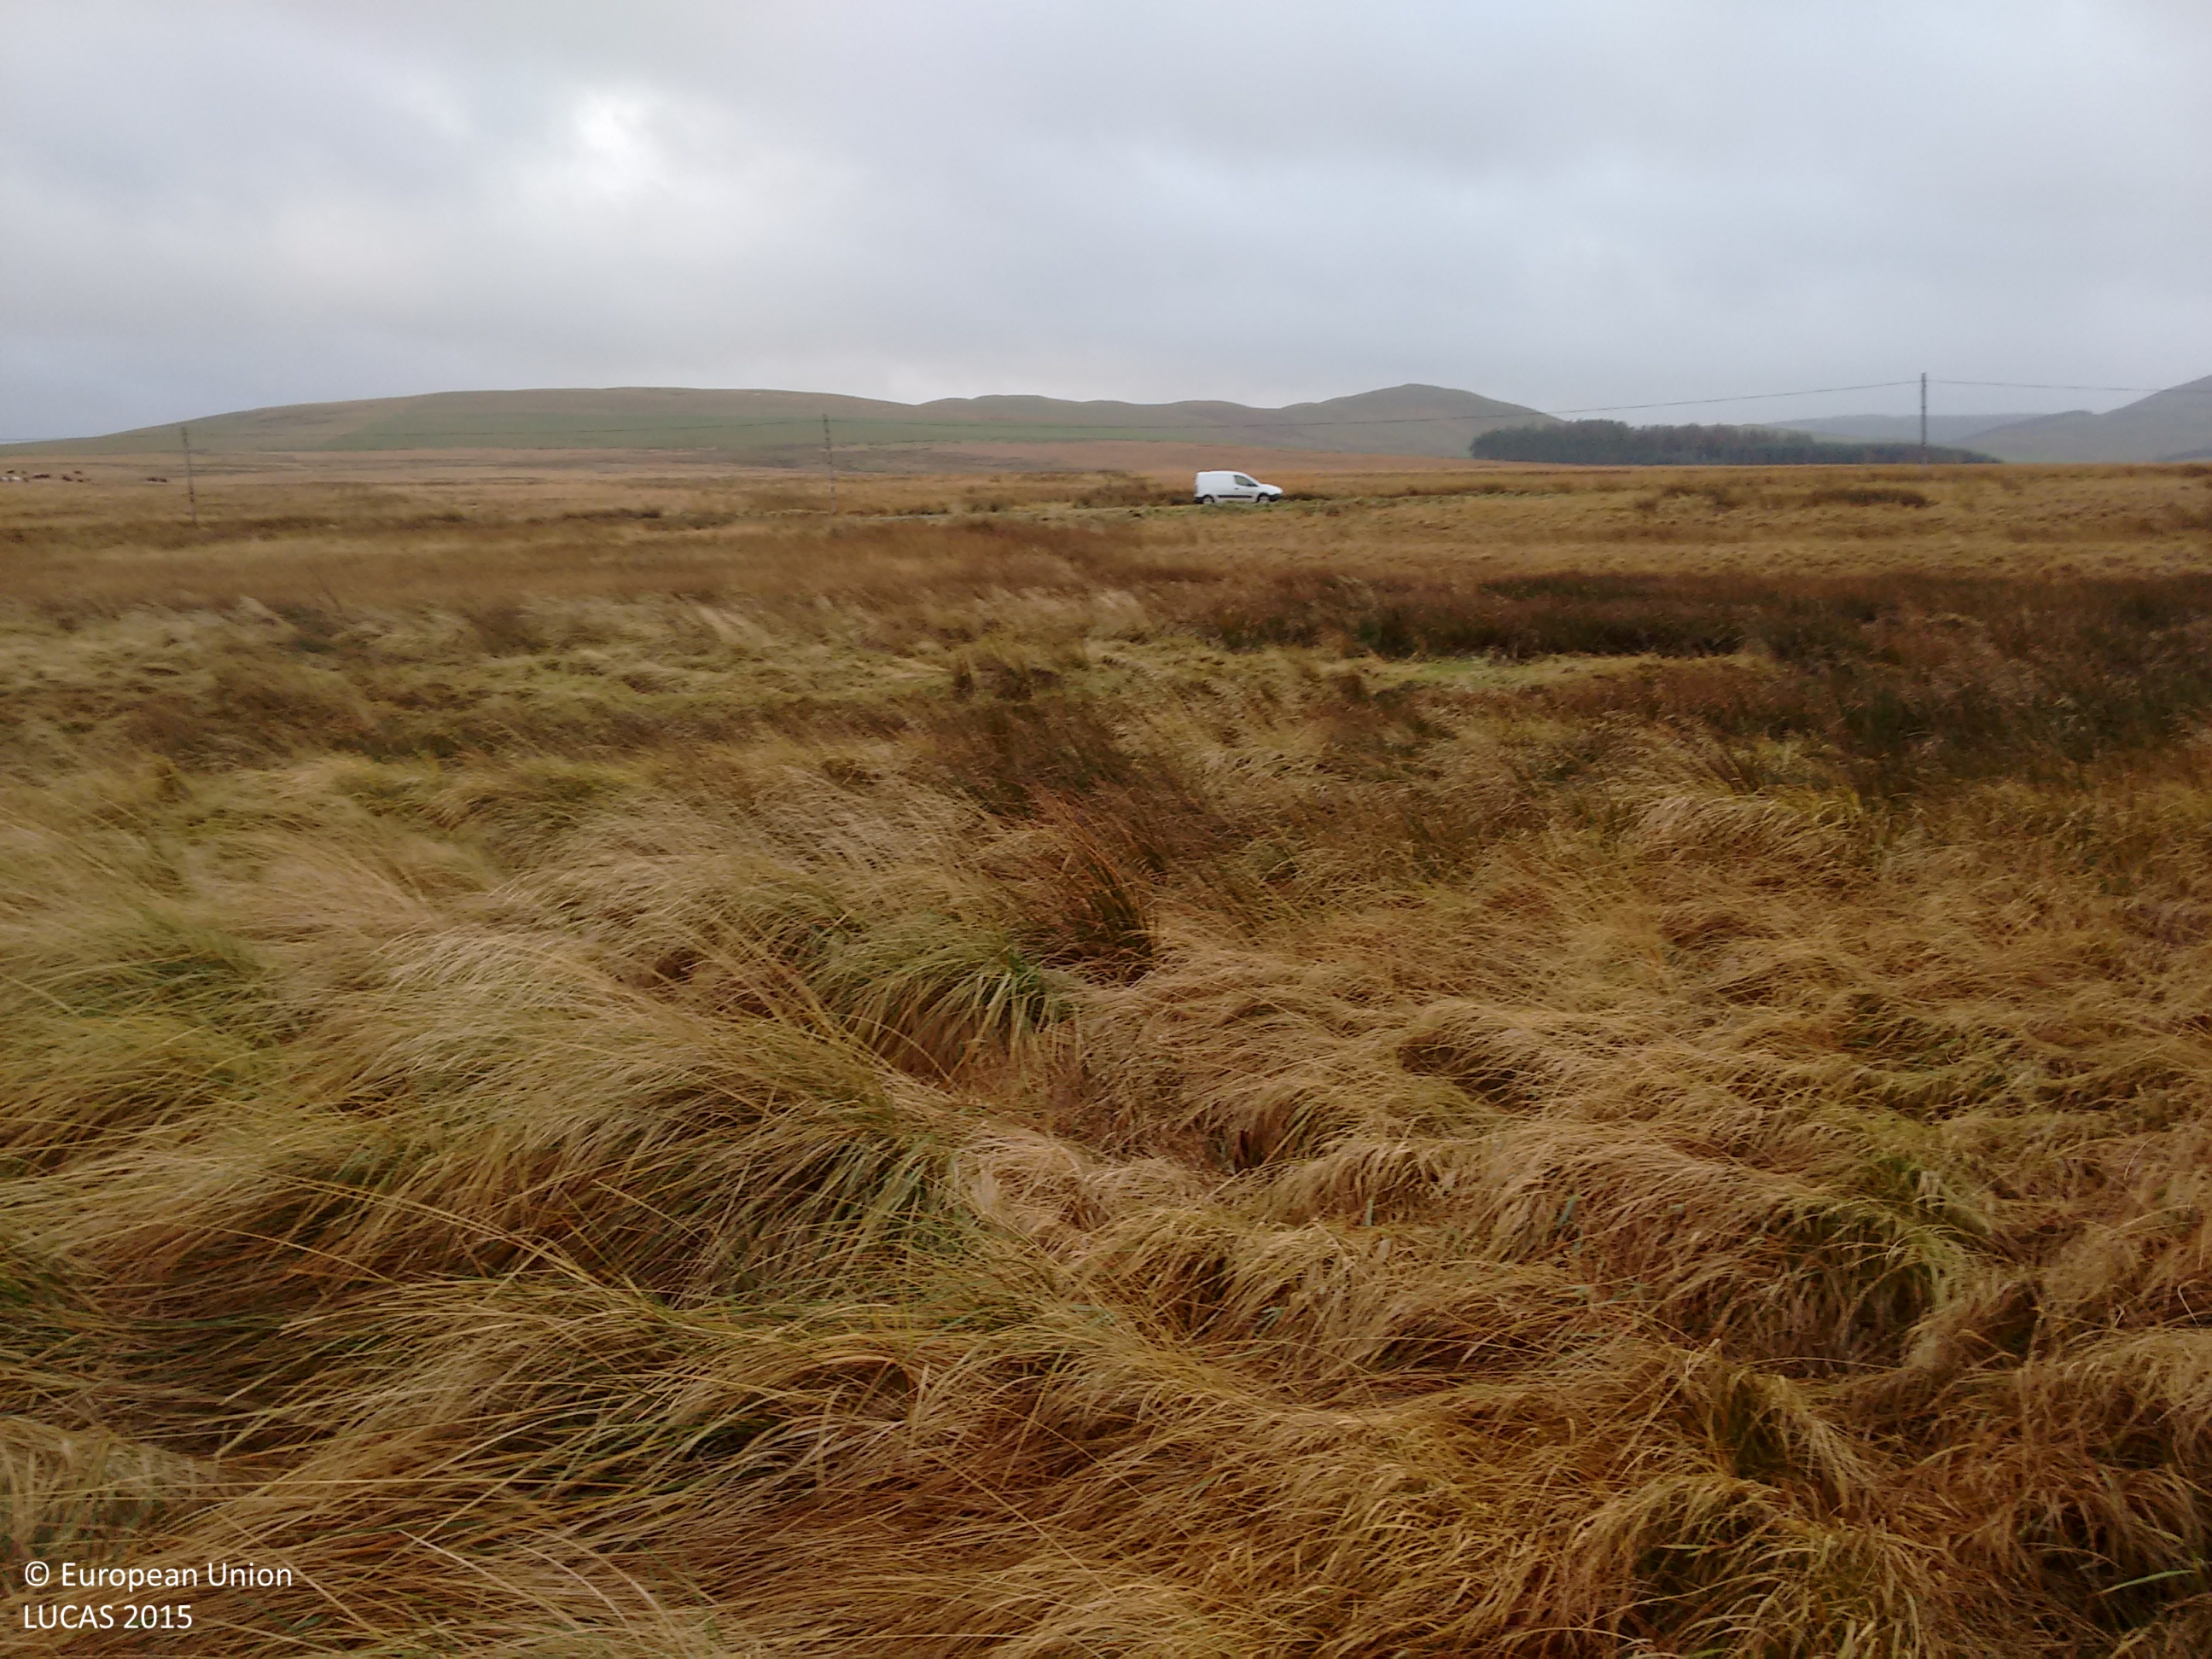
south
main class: Grassland
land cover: Grassland without tree/shrub cover
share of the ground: > 75 %
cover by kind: herbaceous plants 100 %
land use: Agriculture (excluding fallow land and kitchen gardens)
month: December
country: GB
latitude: 55.4197
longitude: -2.3982
